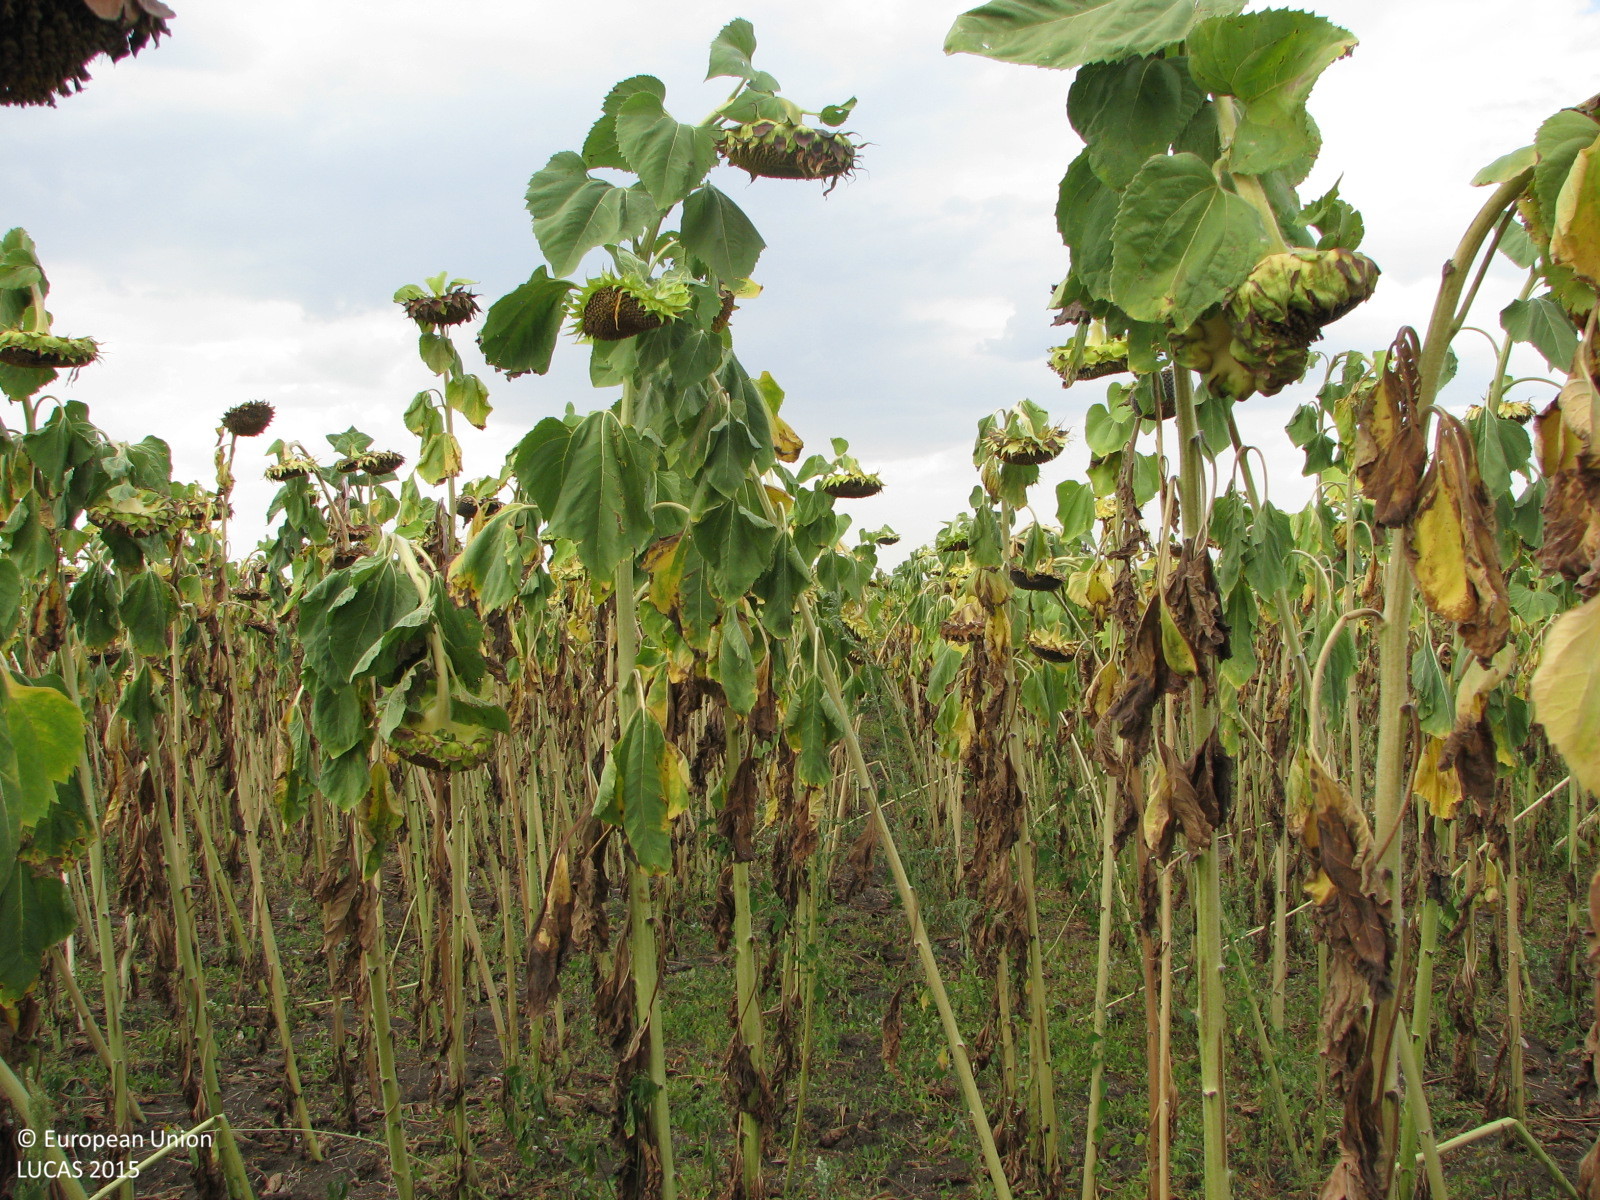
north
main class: Cropland
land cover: Sunflower
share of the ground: > 75 %
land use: Agriculture (excluding fallow land and kitchen gardens)
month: August
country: BG
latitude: 42.4027
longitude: 26.5552
